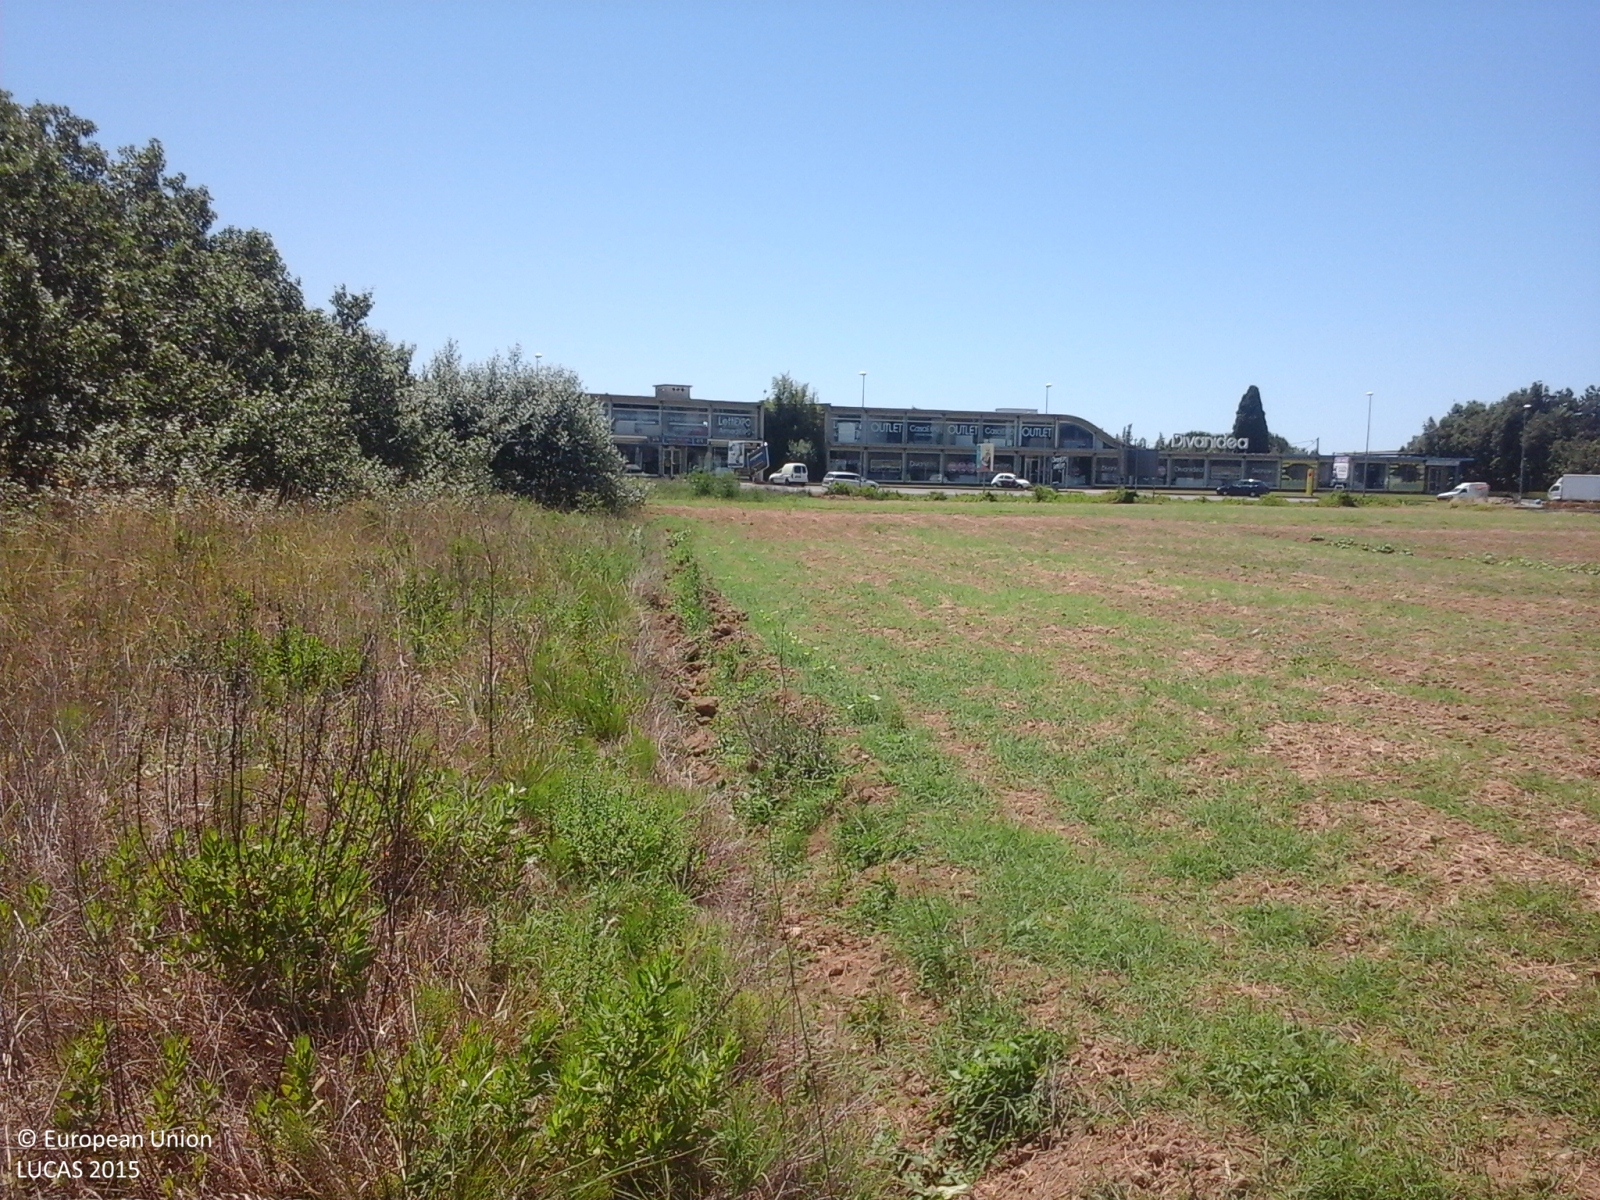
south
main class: Grassland
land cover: Grassland with sparse tree/shrub cover
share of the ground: 50 - 75 %
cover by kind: herbaceous plants 85 %, shrubs 10 %, broadleaved forest trees 5 %
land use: Semi-natural and natural areas not in use
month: June
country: IT
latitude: 43.6091
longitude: 10.6054
